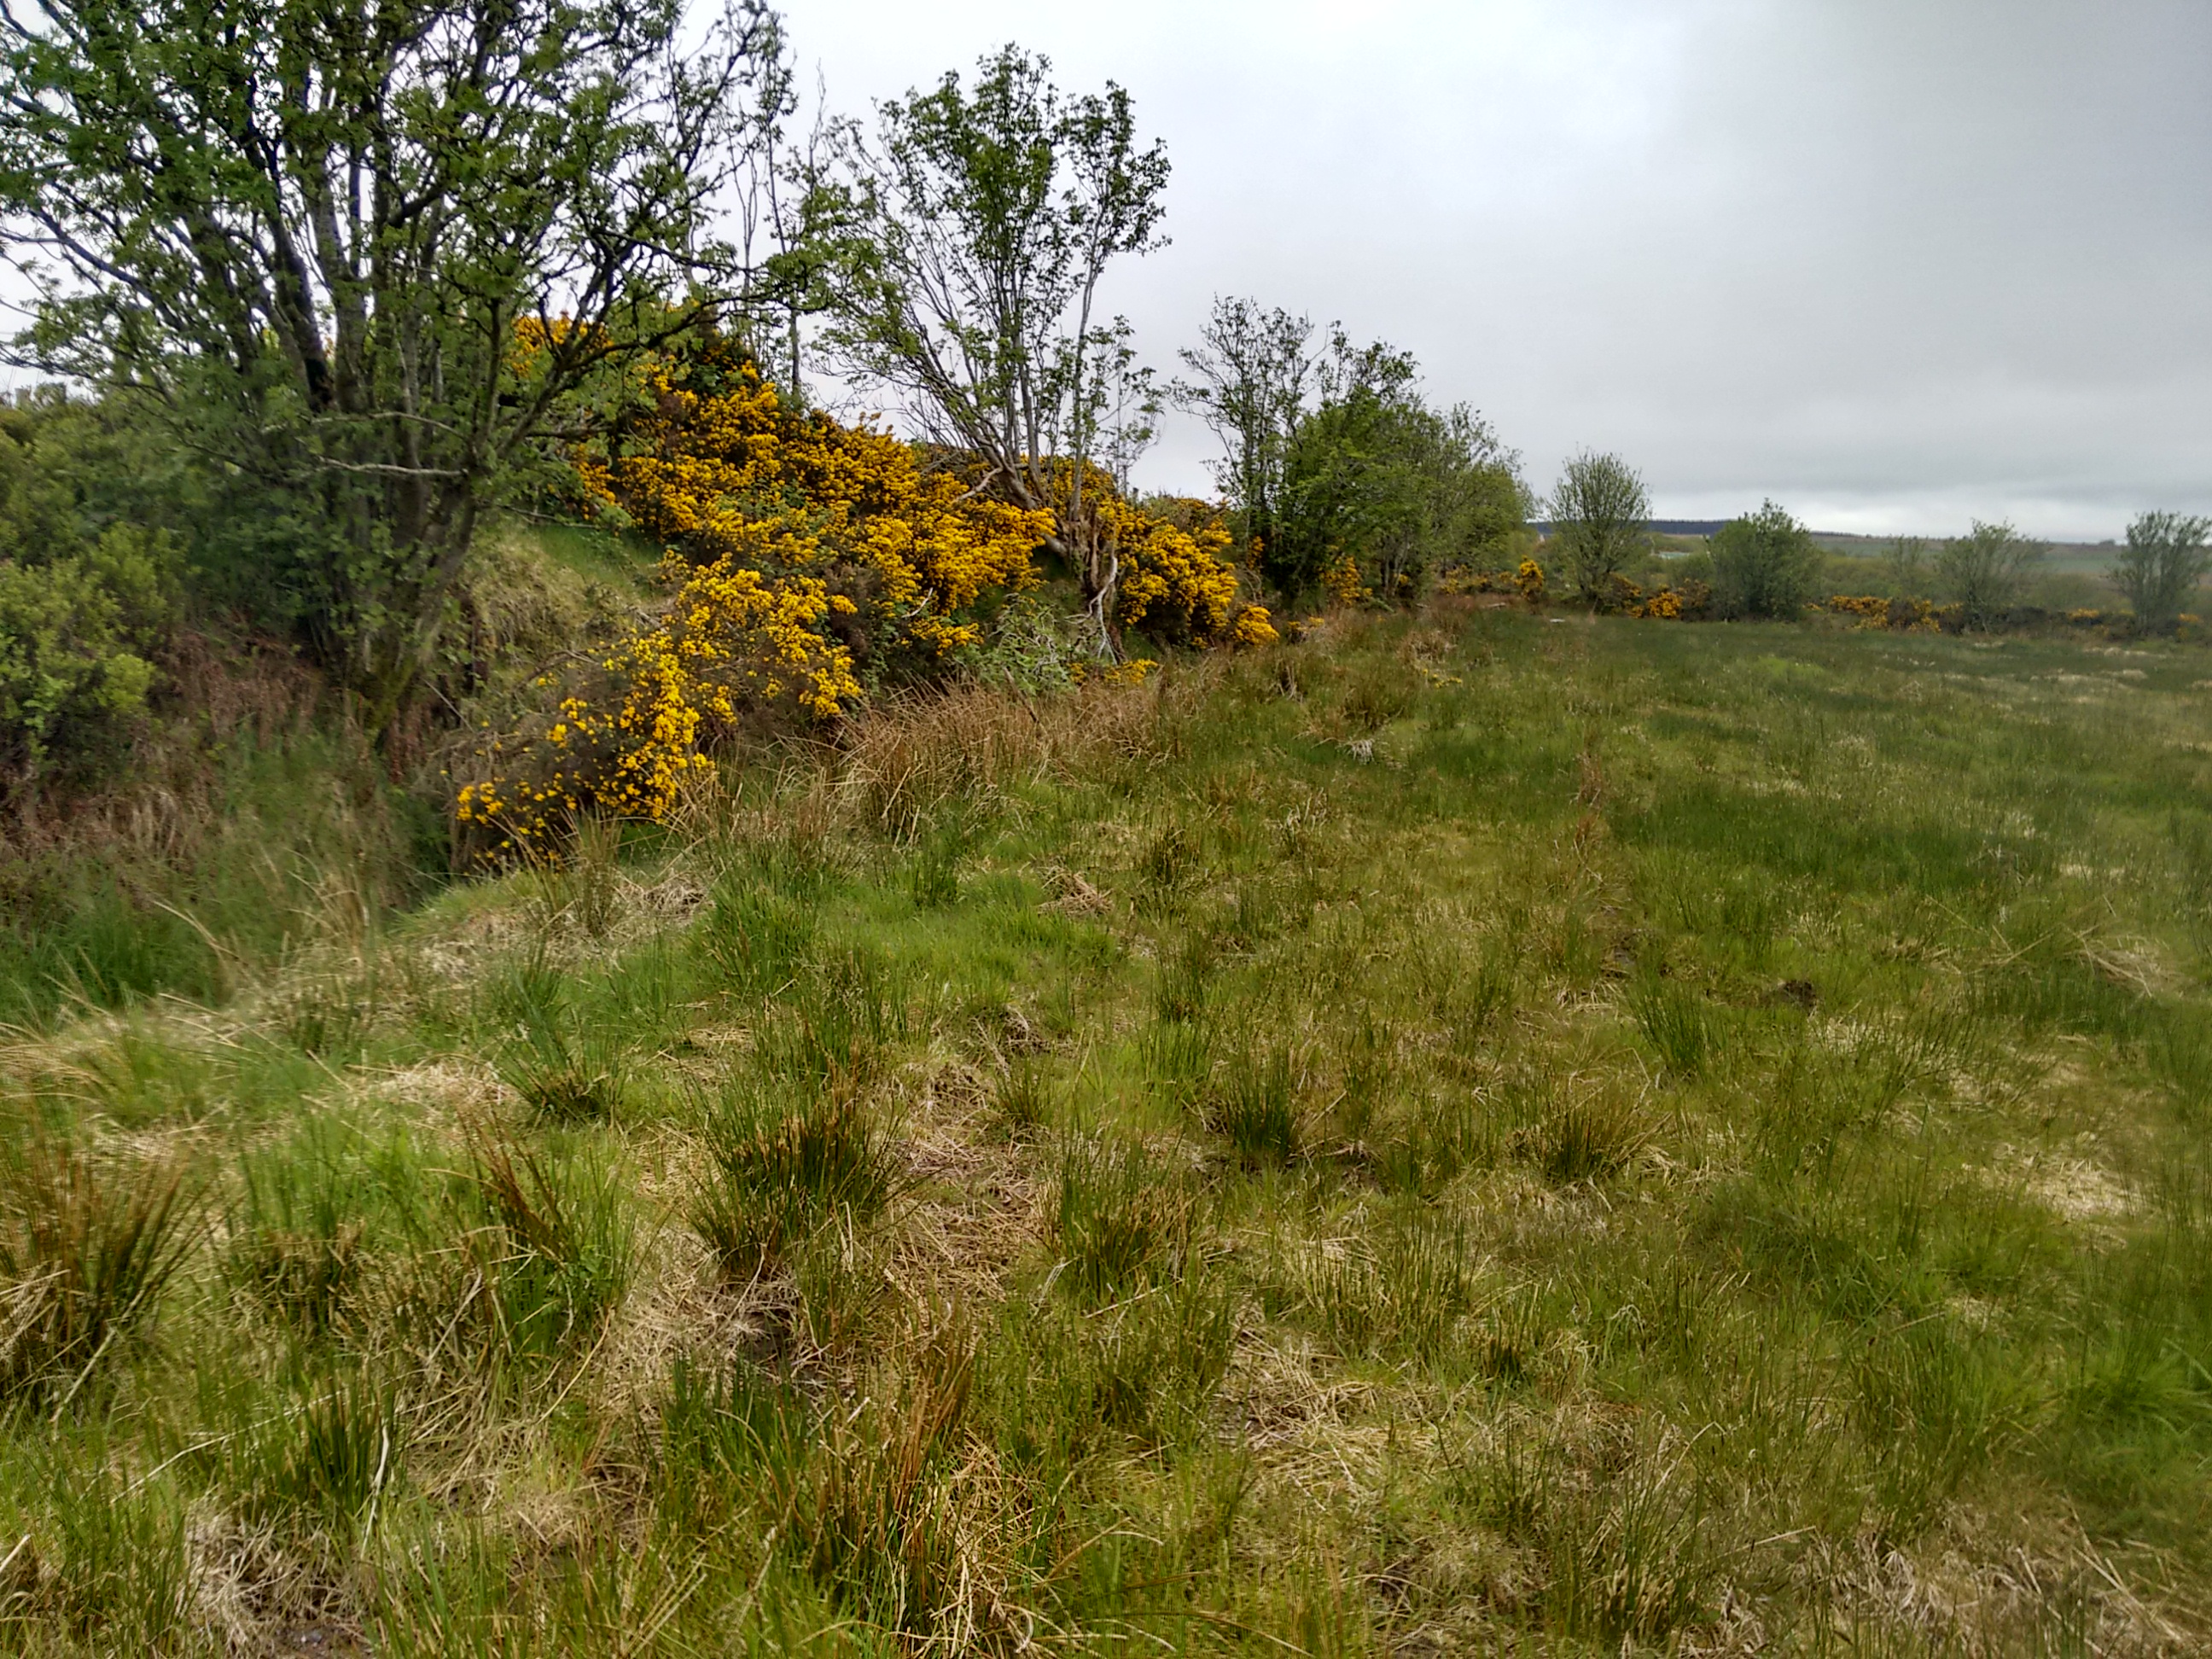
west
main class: Grassland
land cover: Grassland without tree/shrub cover
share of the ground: > 75 %
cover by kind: herbaceous plants 100 %
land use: Agriculture (excluding fallow land and kitchen gardens)
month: May
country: GB
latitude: 54.9984
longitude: -7.0376
